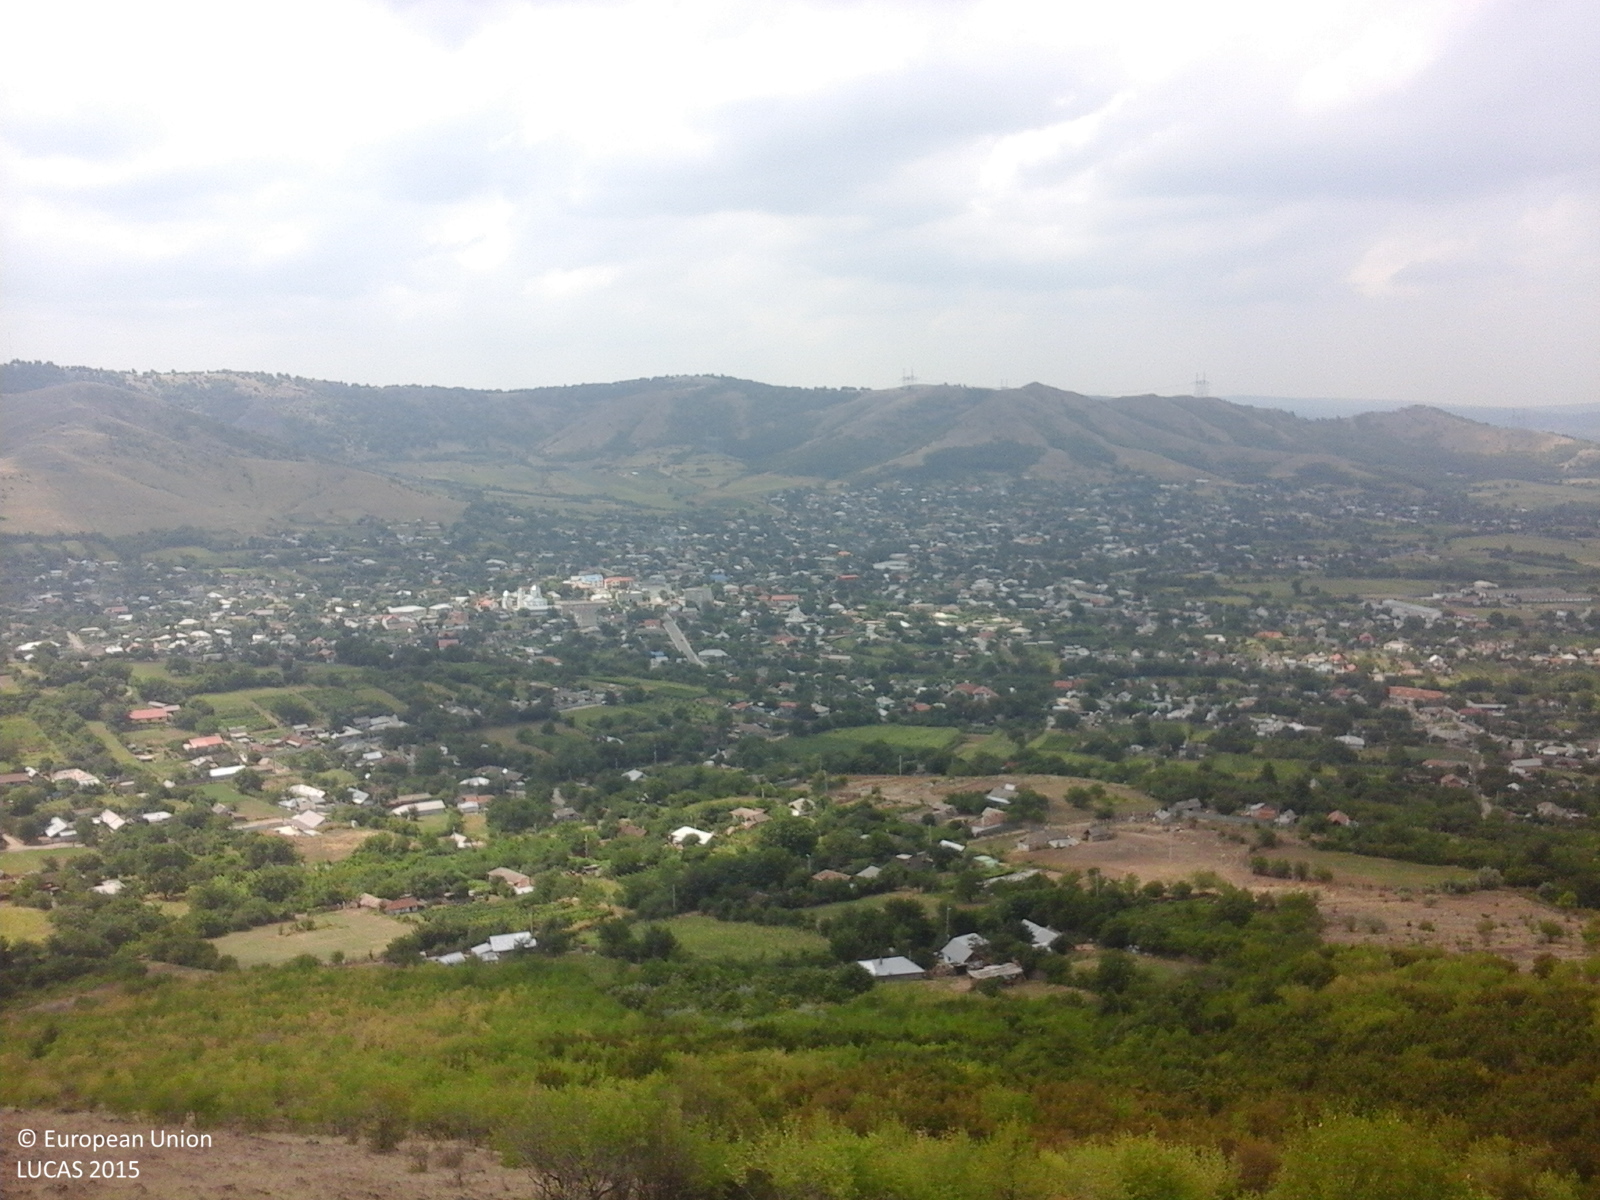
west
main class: Grassland
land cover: Grassland without tree/shrub cover
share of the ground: > 75 %
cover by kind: herbaceous plants 85 %, consolidated bare surface 15 %
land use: Semi-natural and natural areas not in use
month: July
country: RO
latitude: 45.1815
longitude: 28.4944
